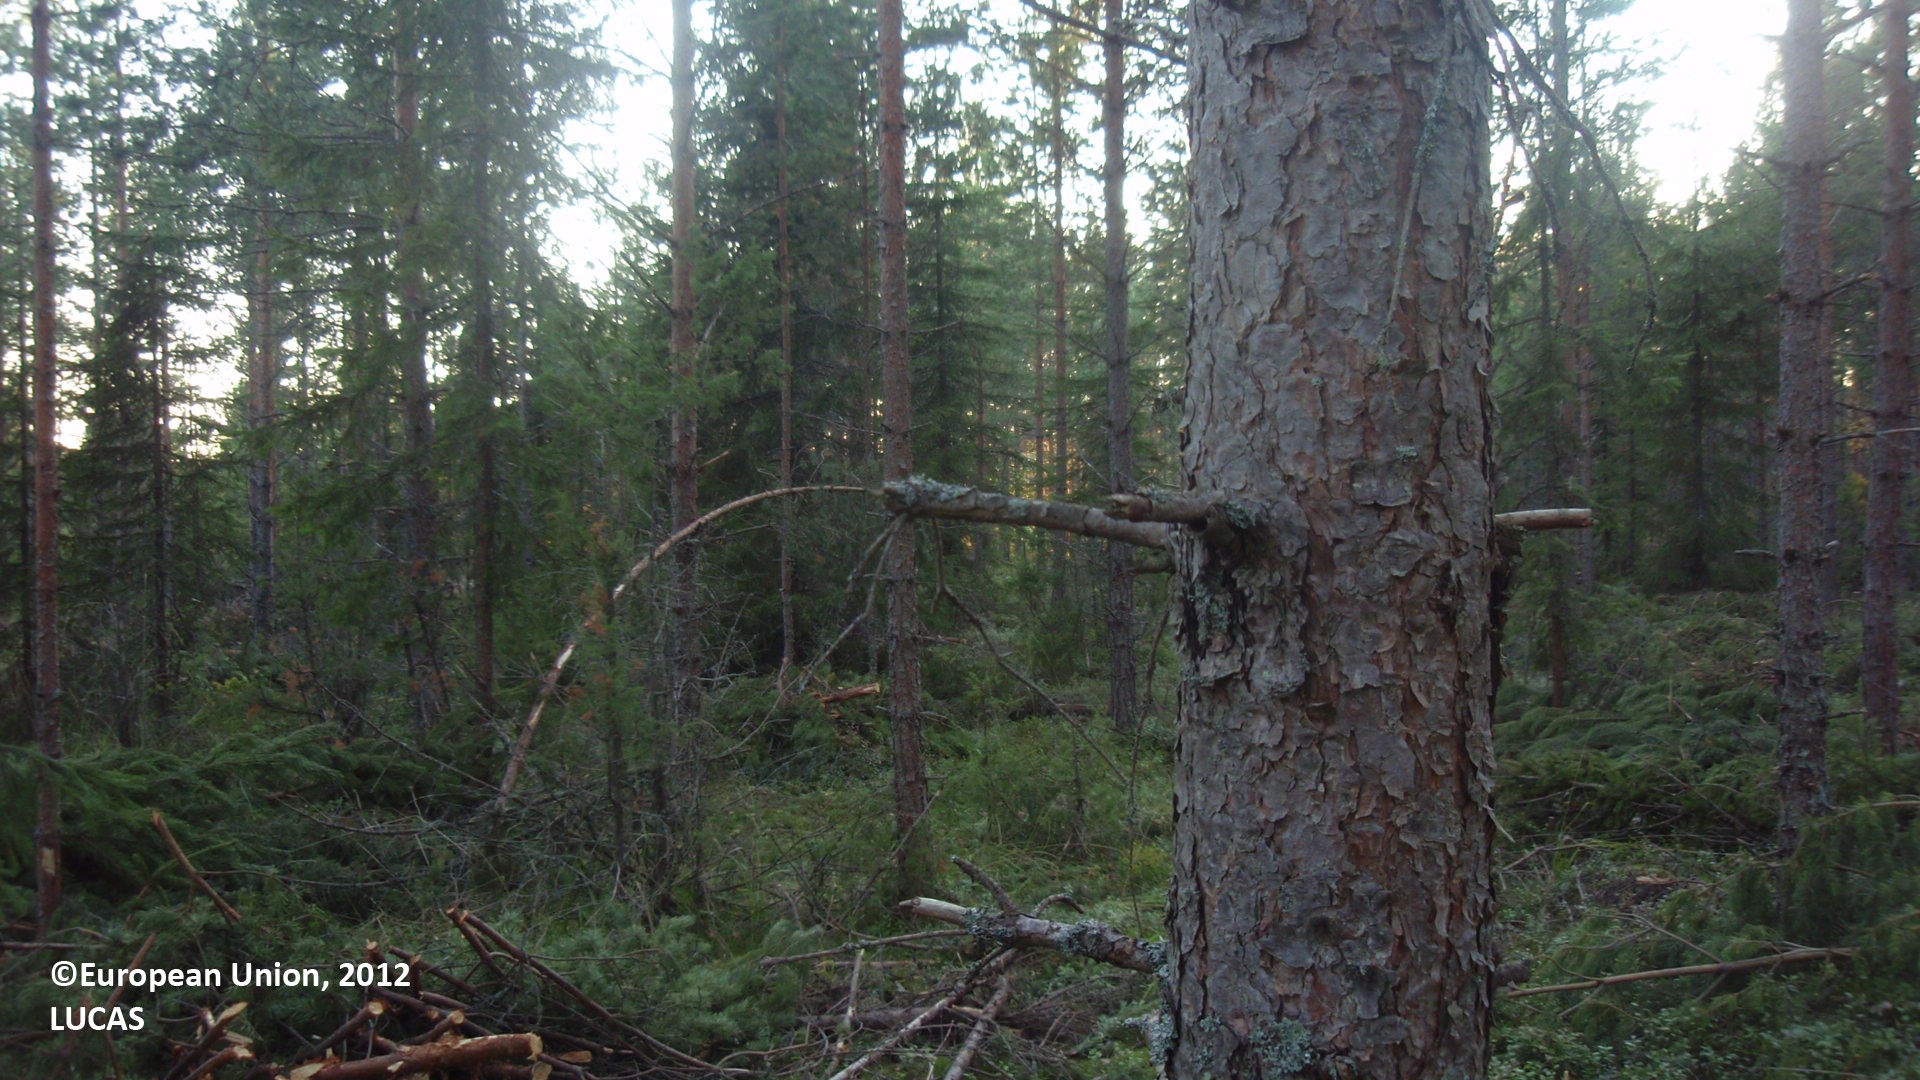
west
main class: Woodland
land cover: Pine dominated coniferous woodland
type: boreal forest
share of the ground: 50 - 75 %
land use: Forestry
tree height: > 5 m
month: August
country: FI
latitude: 60.5292
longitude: 27.4029
